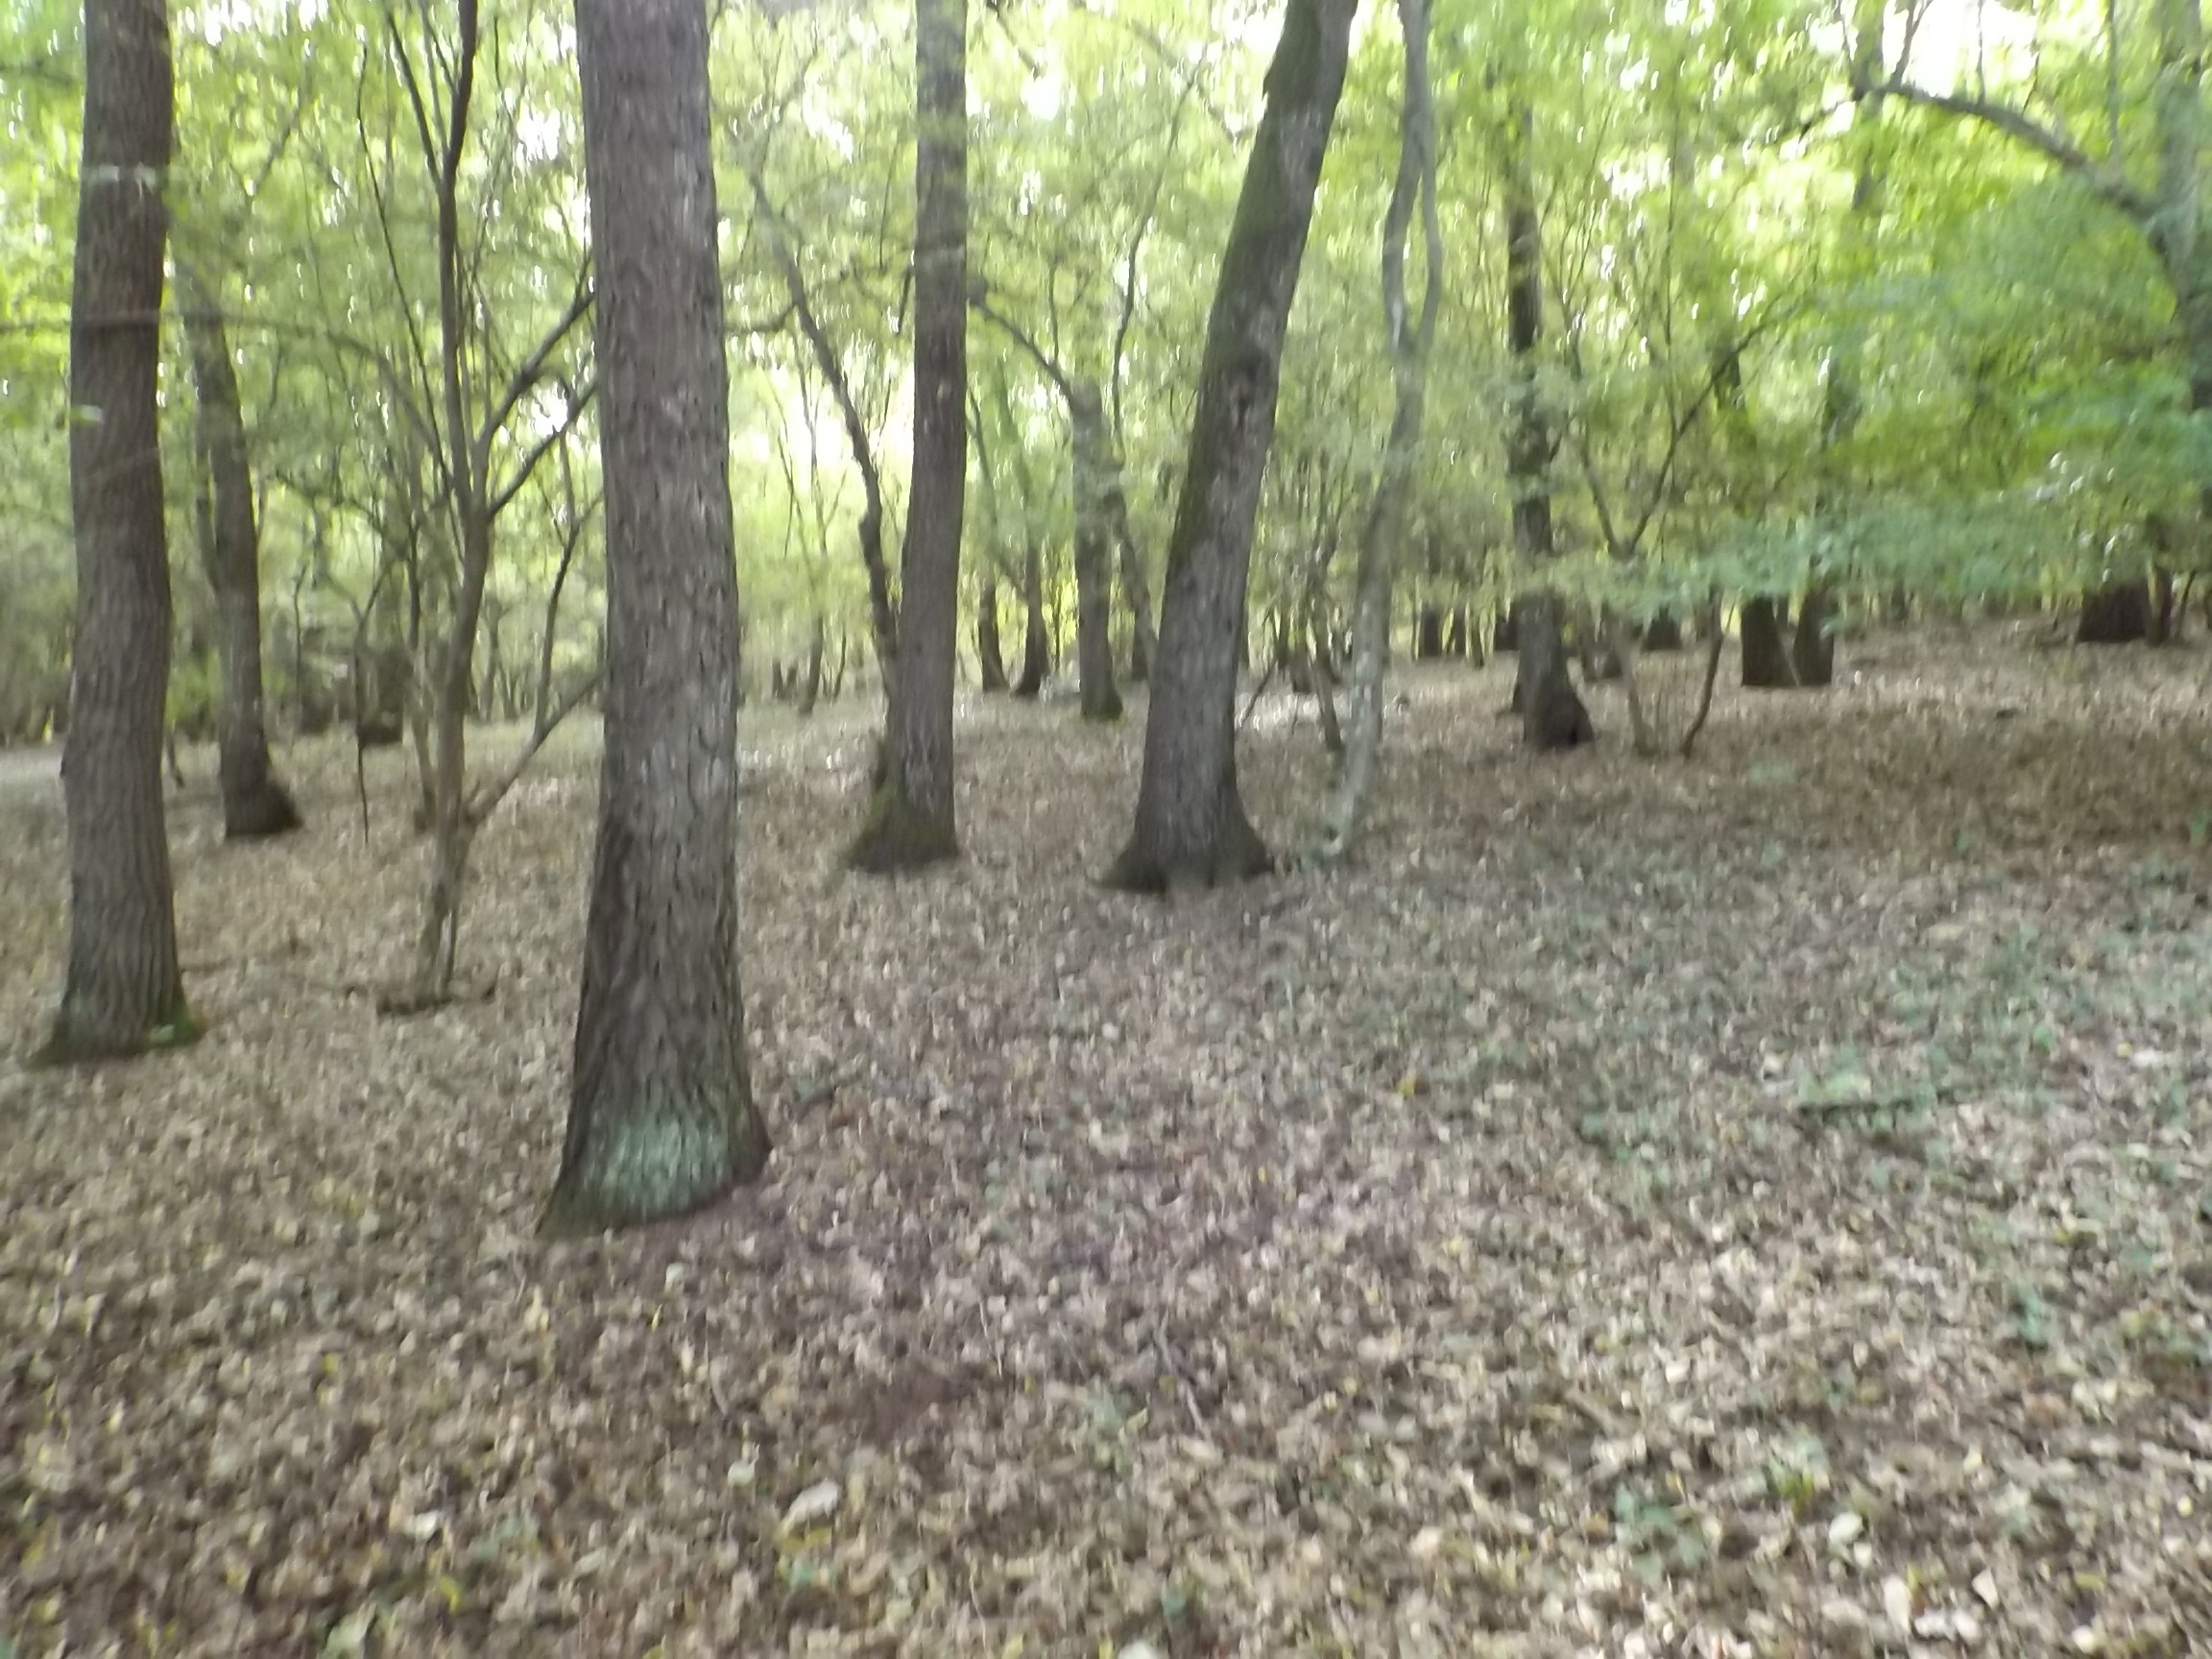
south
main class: Woodland
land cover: Broadleaved woodland
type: beech forest
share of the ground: > 75 %
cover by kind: broadleaved forest trees 100 %
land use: Forestry
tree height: > 5 m
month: October
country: BG
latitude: 43.9032
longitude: 26.7113
